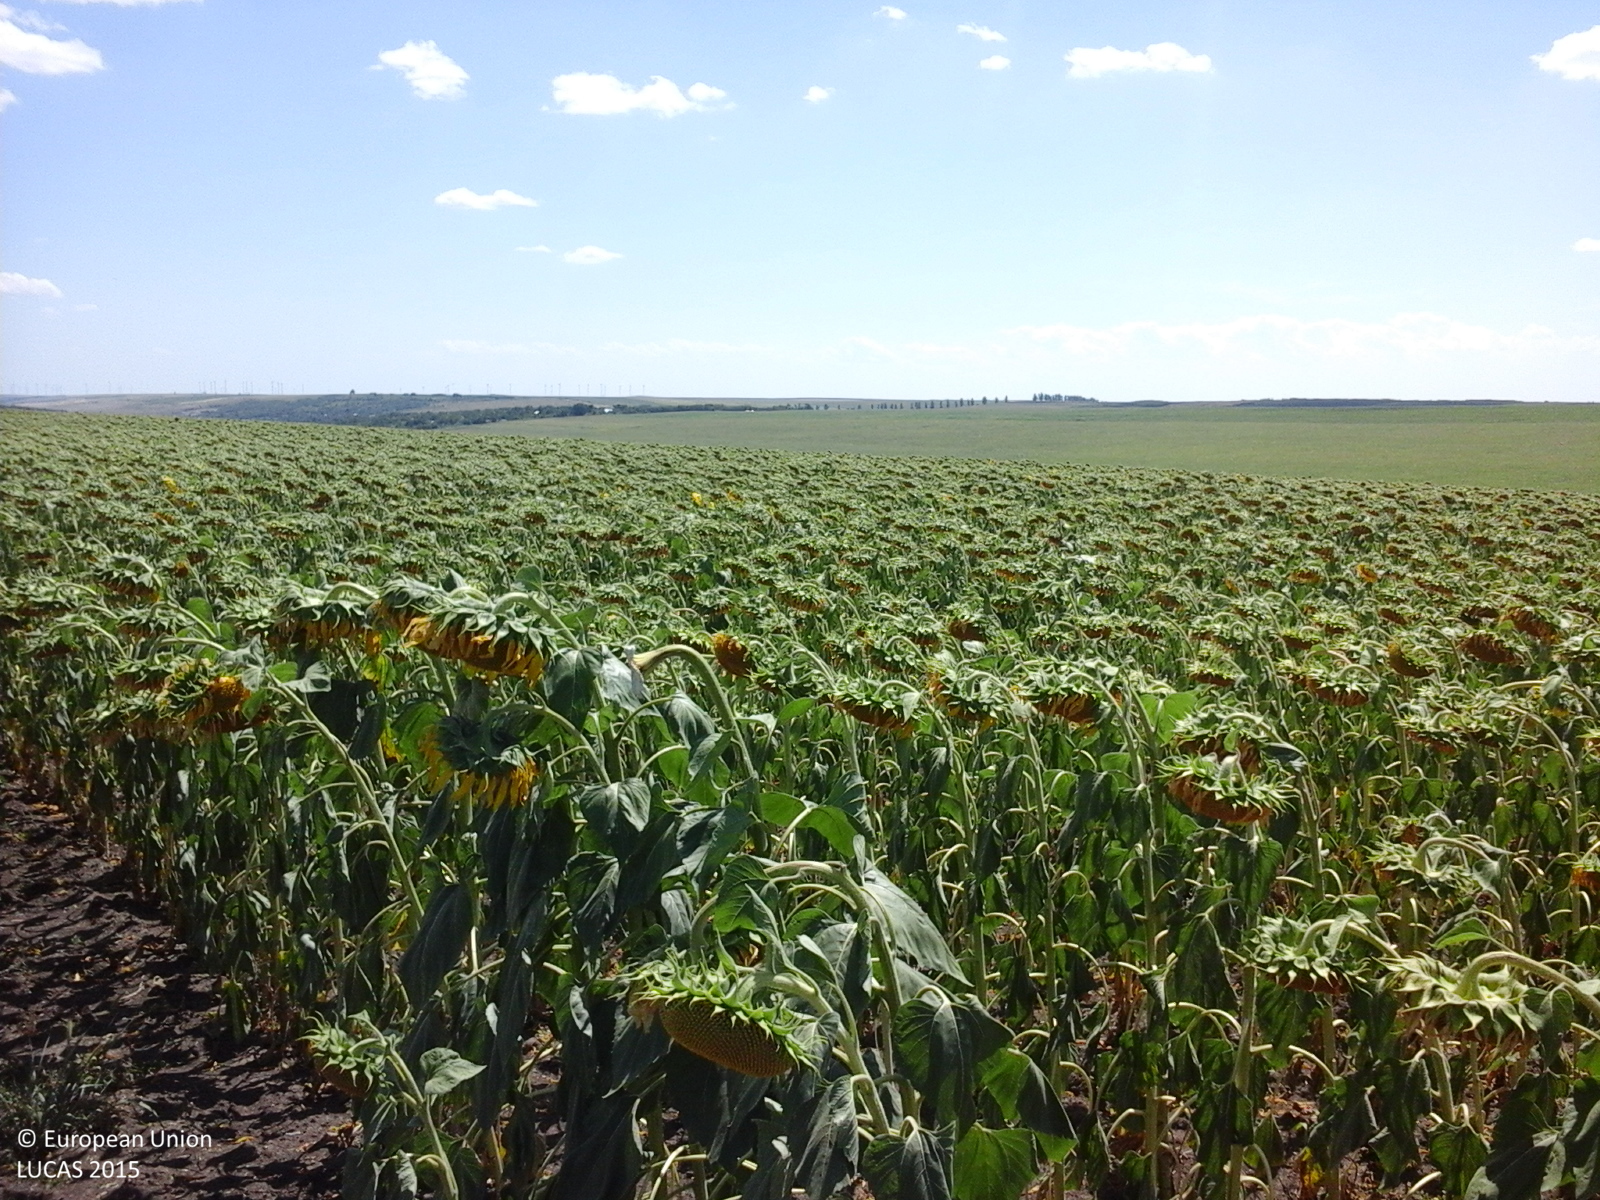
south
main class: Cropland
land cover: Sunflower
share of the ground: > 75 %
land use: Agriculture (excluding fallow land and kitchen gardens)
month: July
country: RO
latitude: 45.9565
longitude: 27.7515
